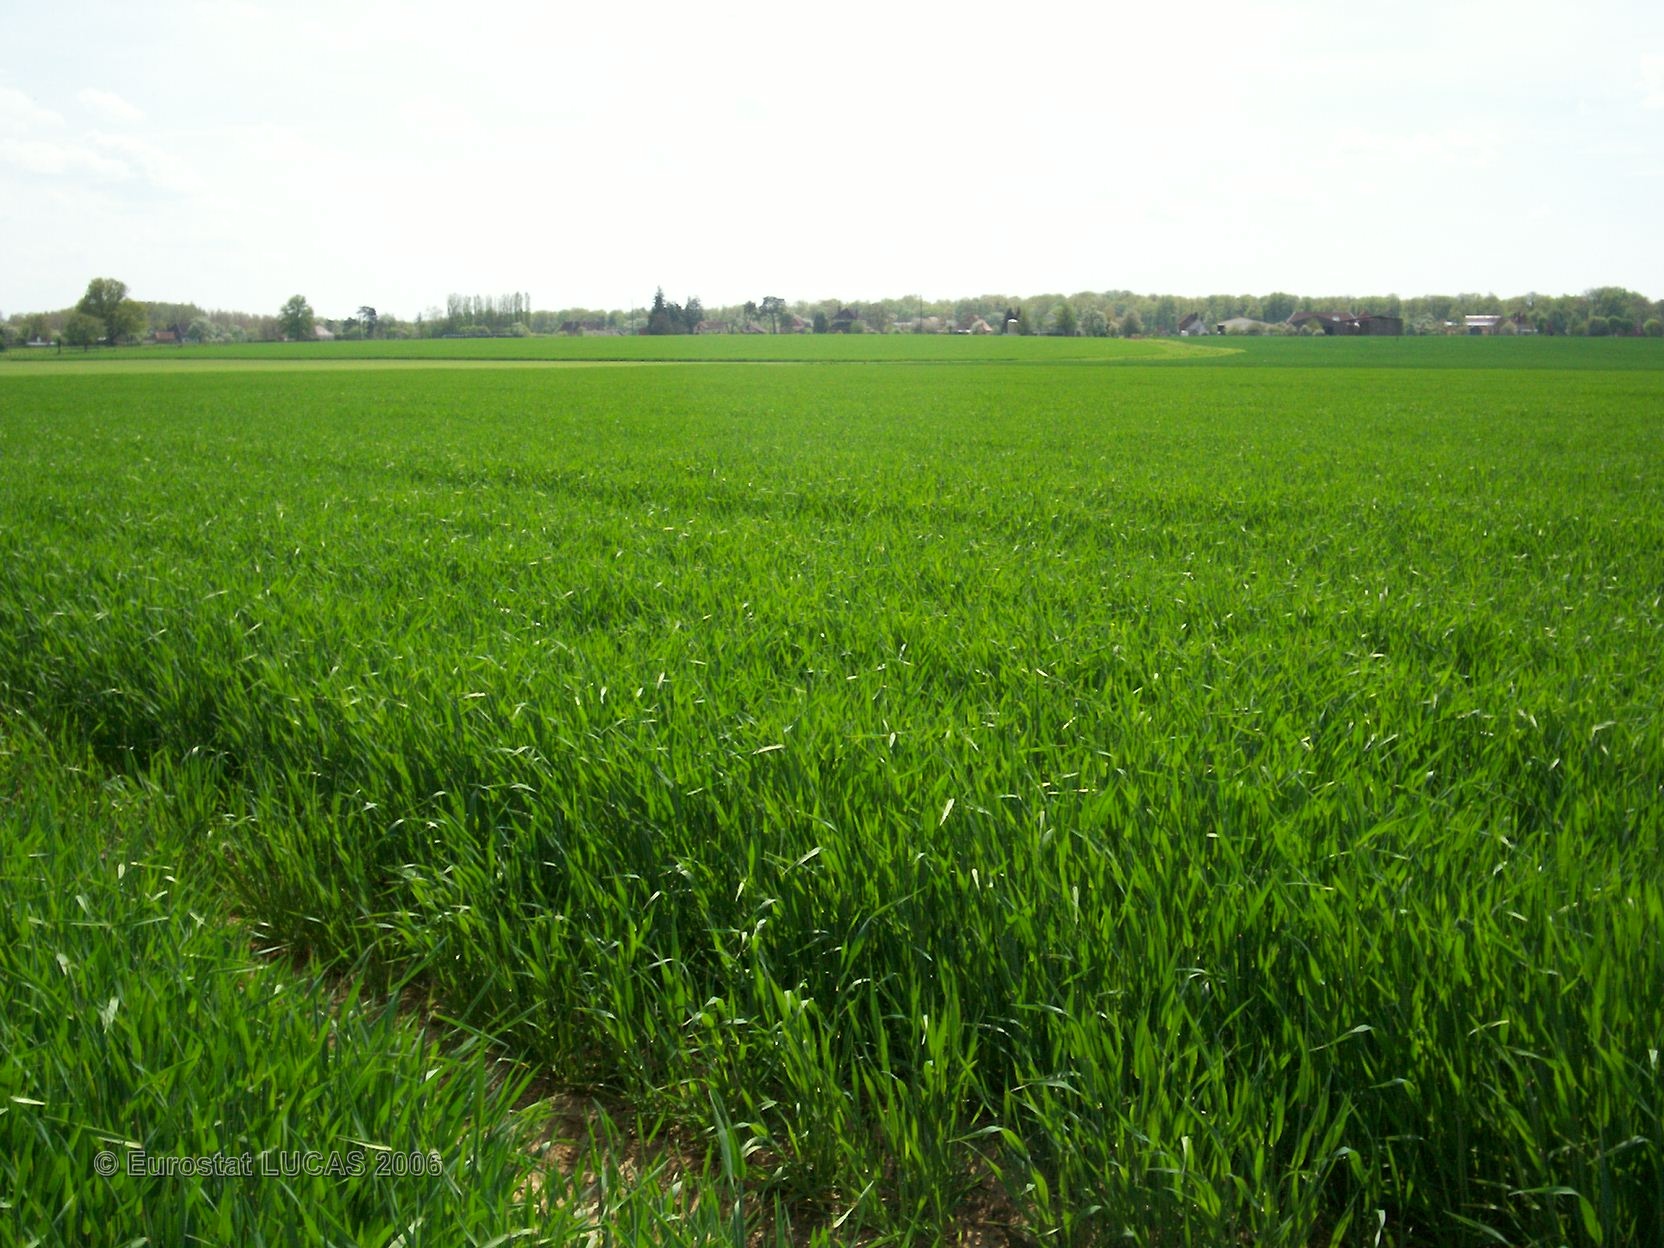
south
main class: Cropland
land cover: Barley
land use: Agriculture (excluding fallow land and kitchen gardens)
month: May
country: FR
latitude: 48.0213
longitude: 3.9494
